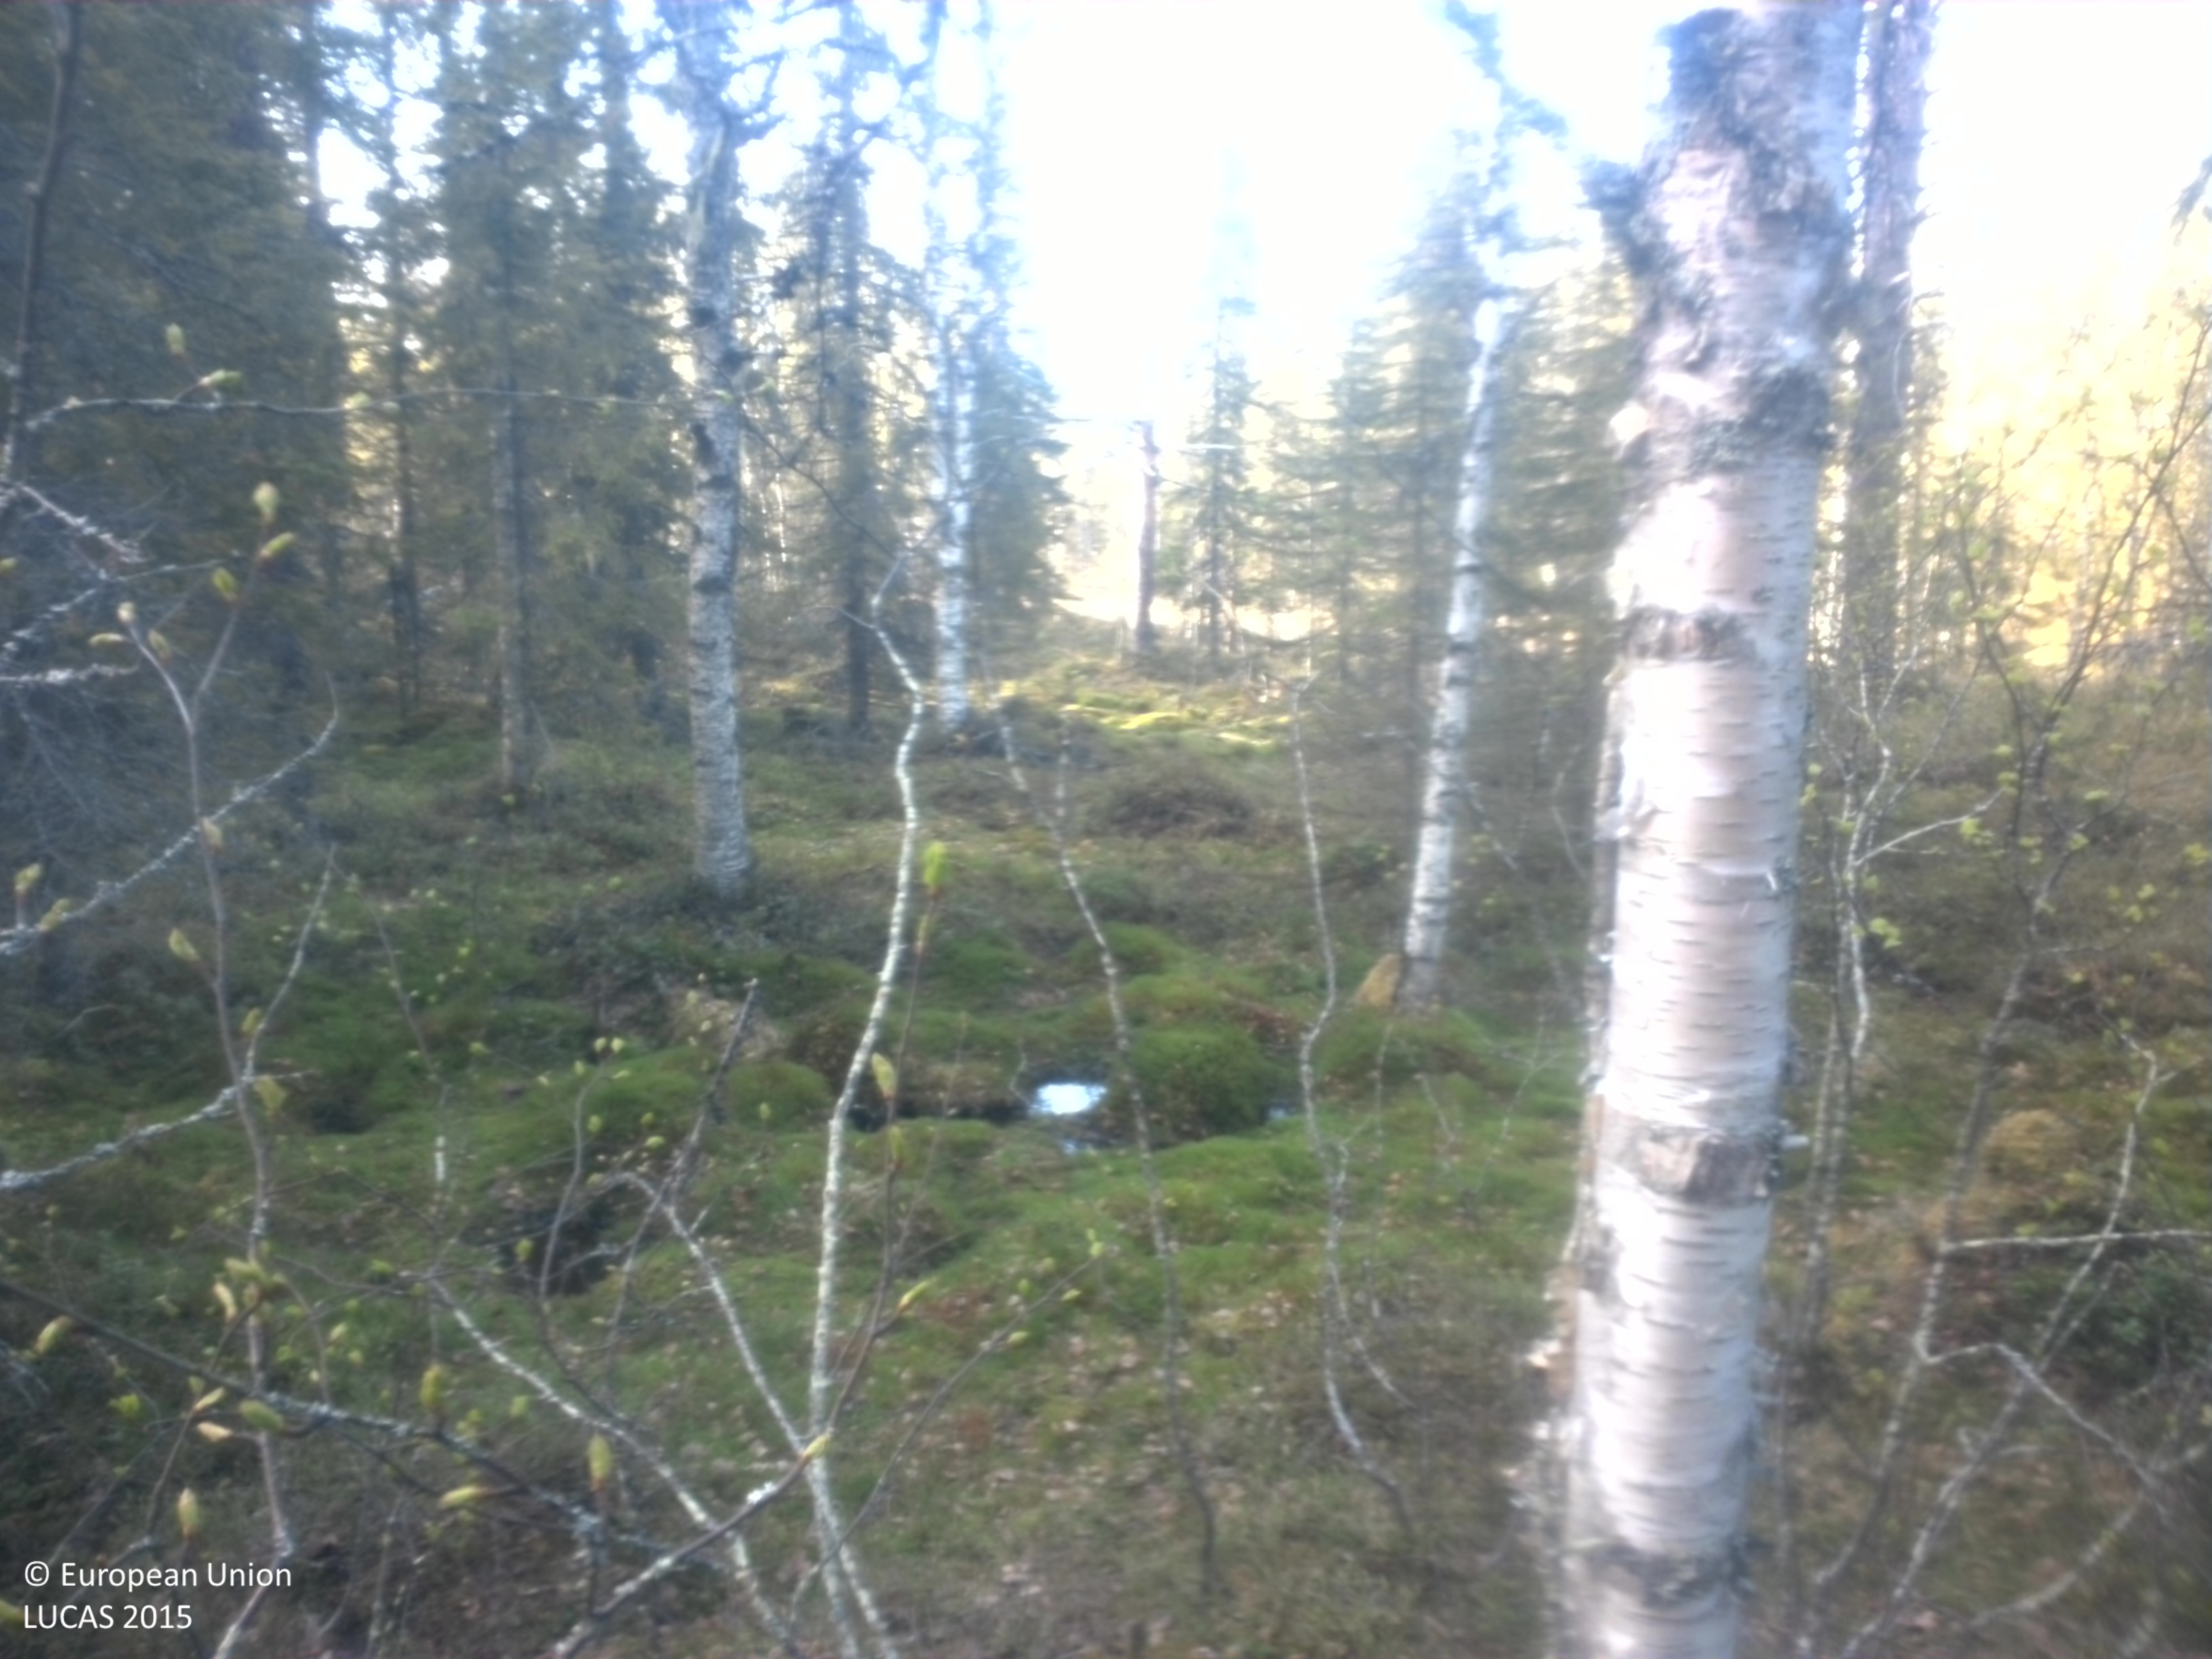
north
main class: Woodland
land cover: Spruce dominated mixed woodland
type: boreal forest
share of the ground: 25 - 50 %
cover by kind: coniferous forest trees 35 %, herbaceous plants 20 %, lichens and mosses 20 %, broadleaved forest trees 15 %, shrubs 5 %
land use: Forestry
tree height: > 5 m
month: June
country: SE
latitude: 64.4622
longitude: 17.7638
